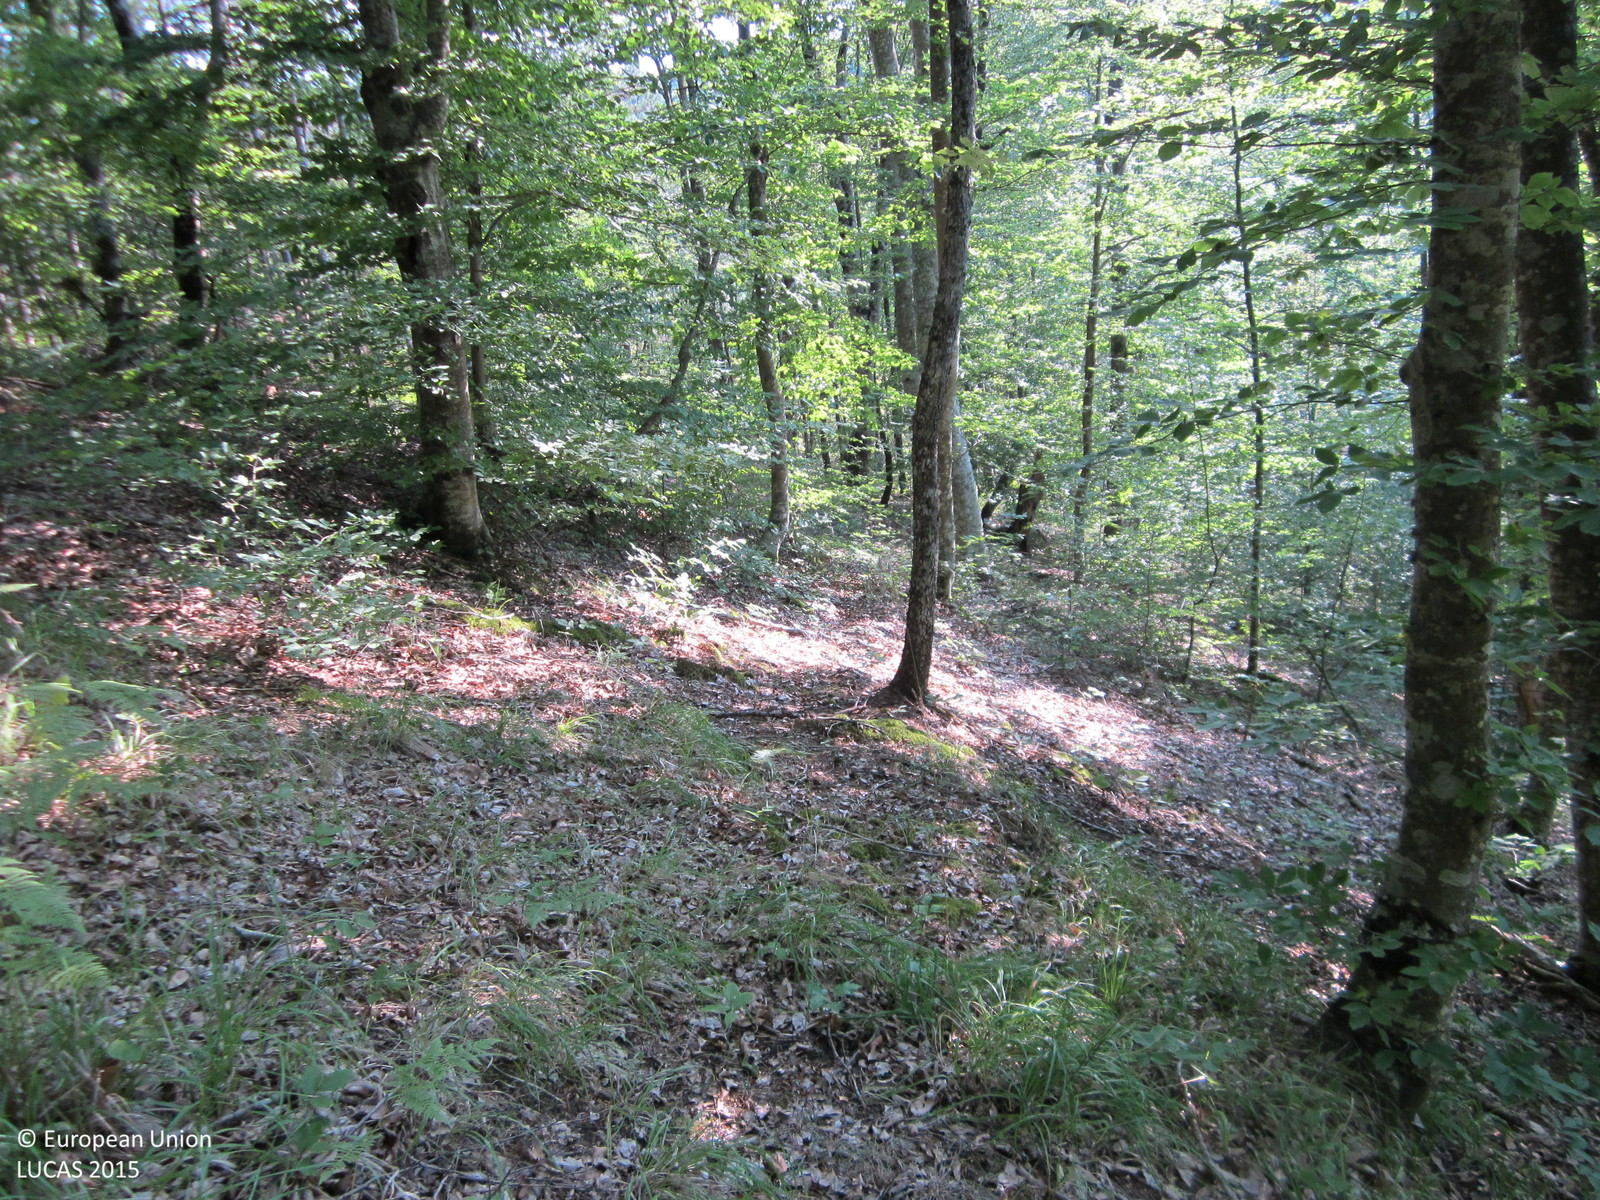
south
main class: Woodland
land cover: Broadleaved woodland
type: beech forest
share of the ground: > 75 %
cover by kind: broadleaved forest trees 80 %, unconsolidated bare surface 10 %, herbaceous plants 5 %, lichens and mosses 5 %
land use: Forestry
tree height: > 5 m
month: August
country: BG
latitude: 42.0392
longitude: 27.4946
